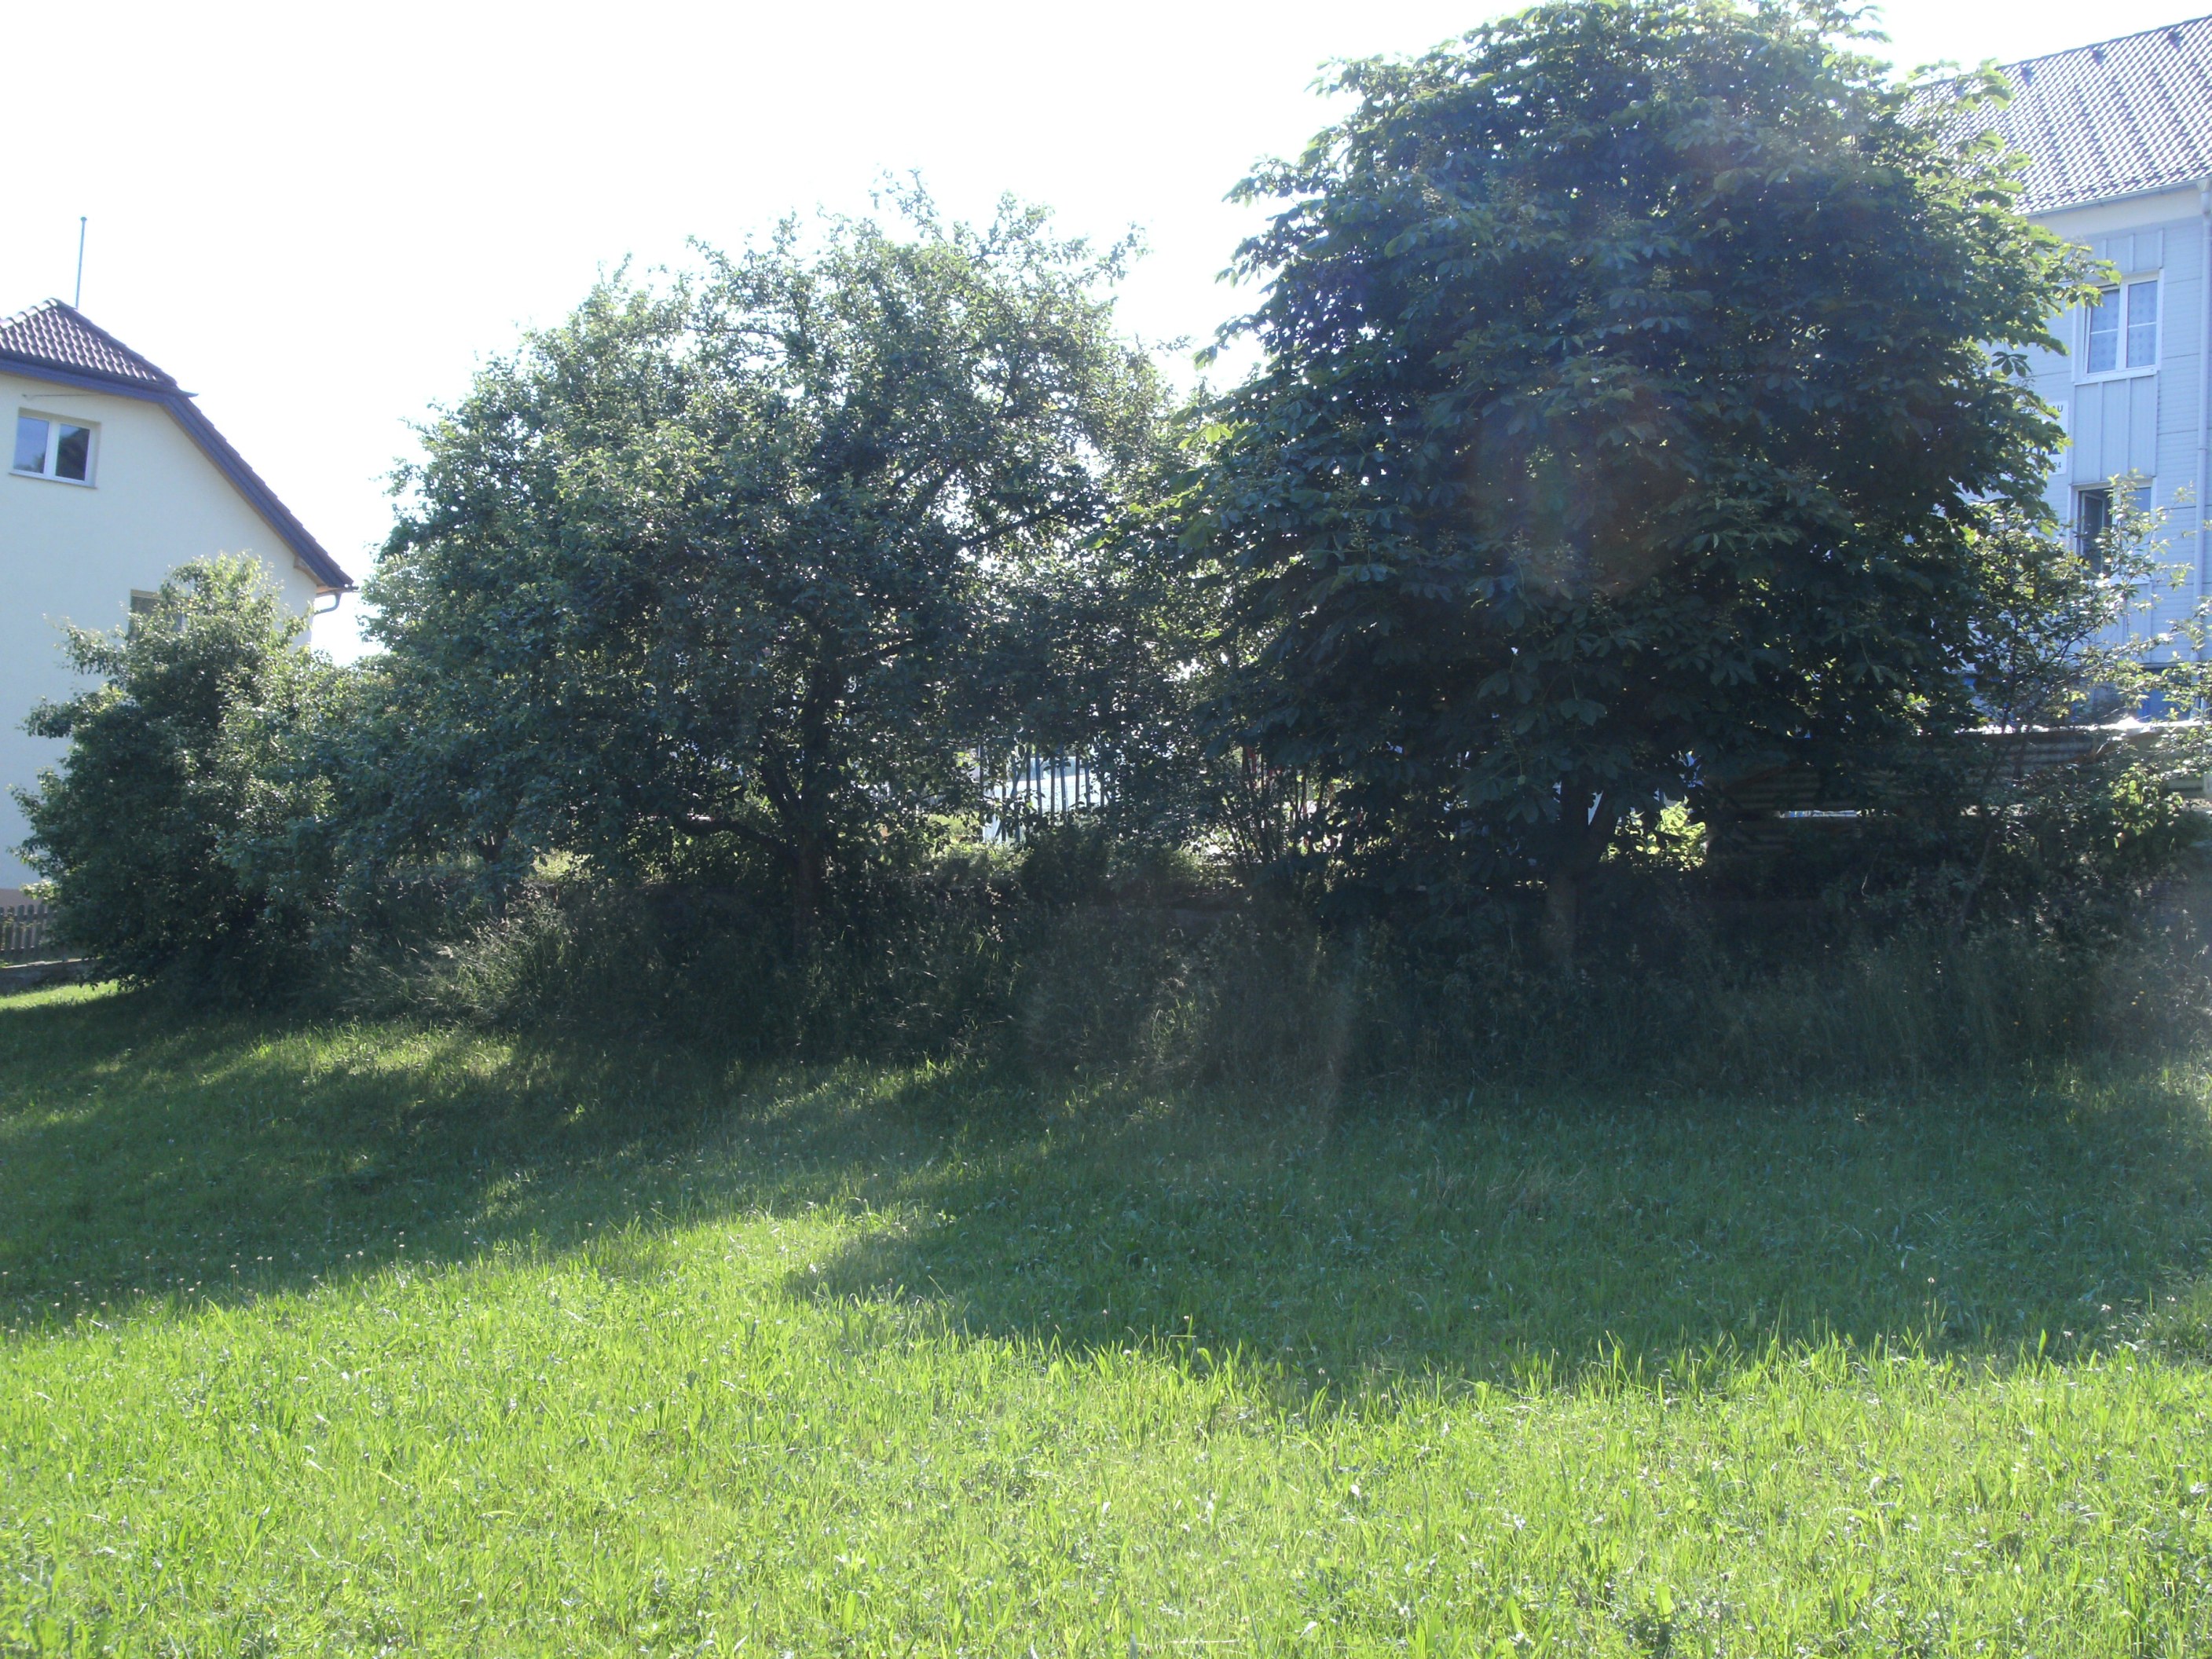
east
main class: Grassland
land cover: Grassland without tree/shrub cover
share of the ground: > 75 %
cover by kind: herbaceous plants 100 %
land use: Agriculture (excluding fallow land and kitchen gardens)
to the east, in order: Grassland without tree/shrub cover; Other fruit trees and berries; Artificial constructions in urban areas; Grassland without tree/shrub cover; Temporary grasslands
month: June
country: AT
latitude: 48.3778
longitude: 14.1990
